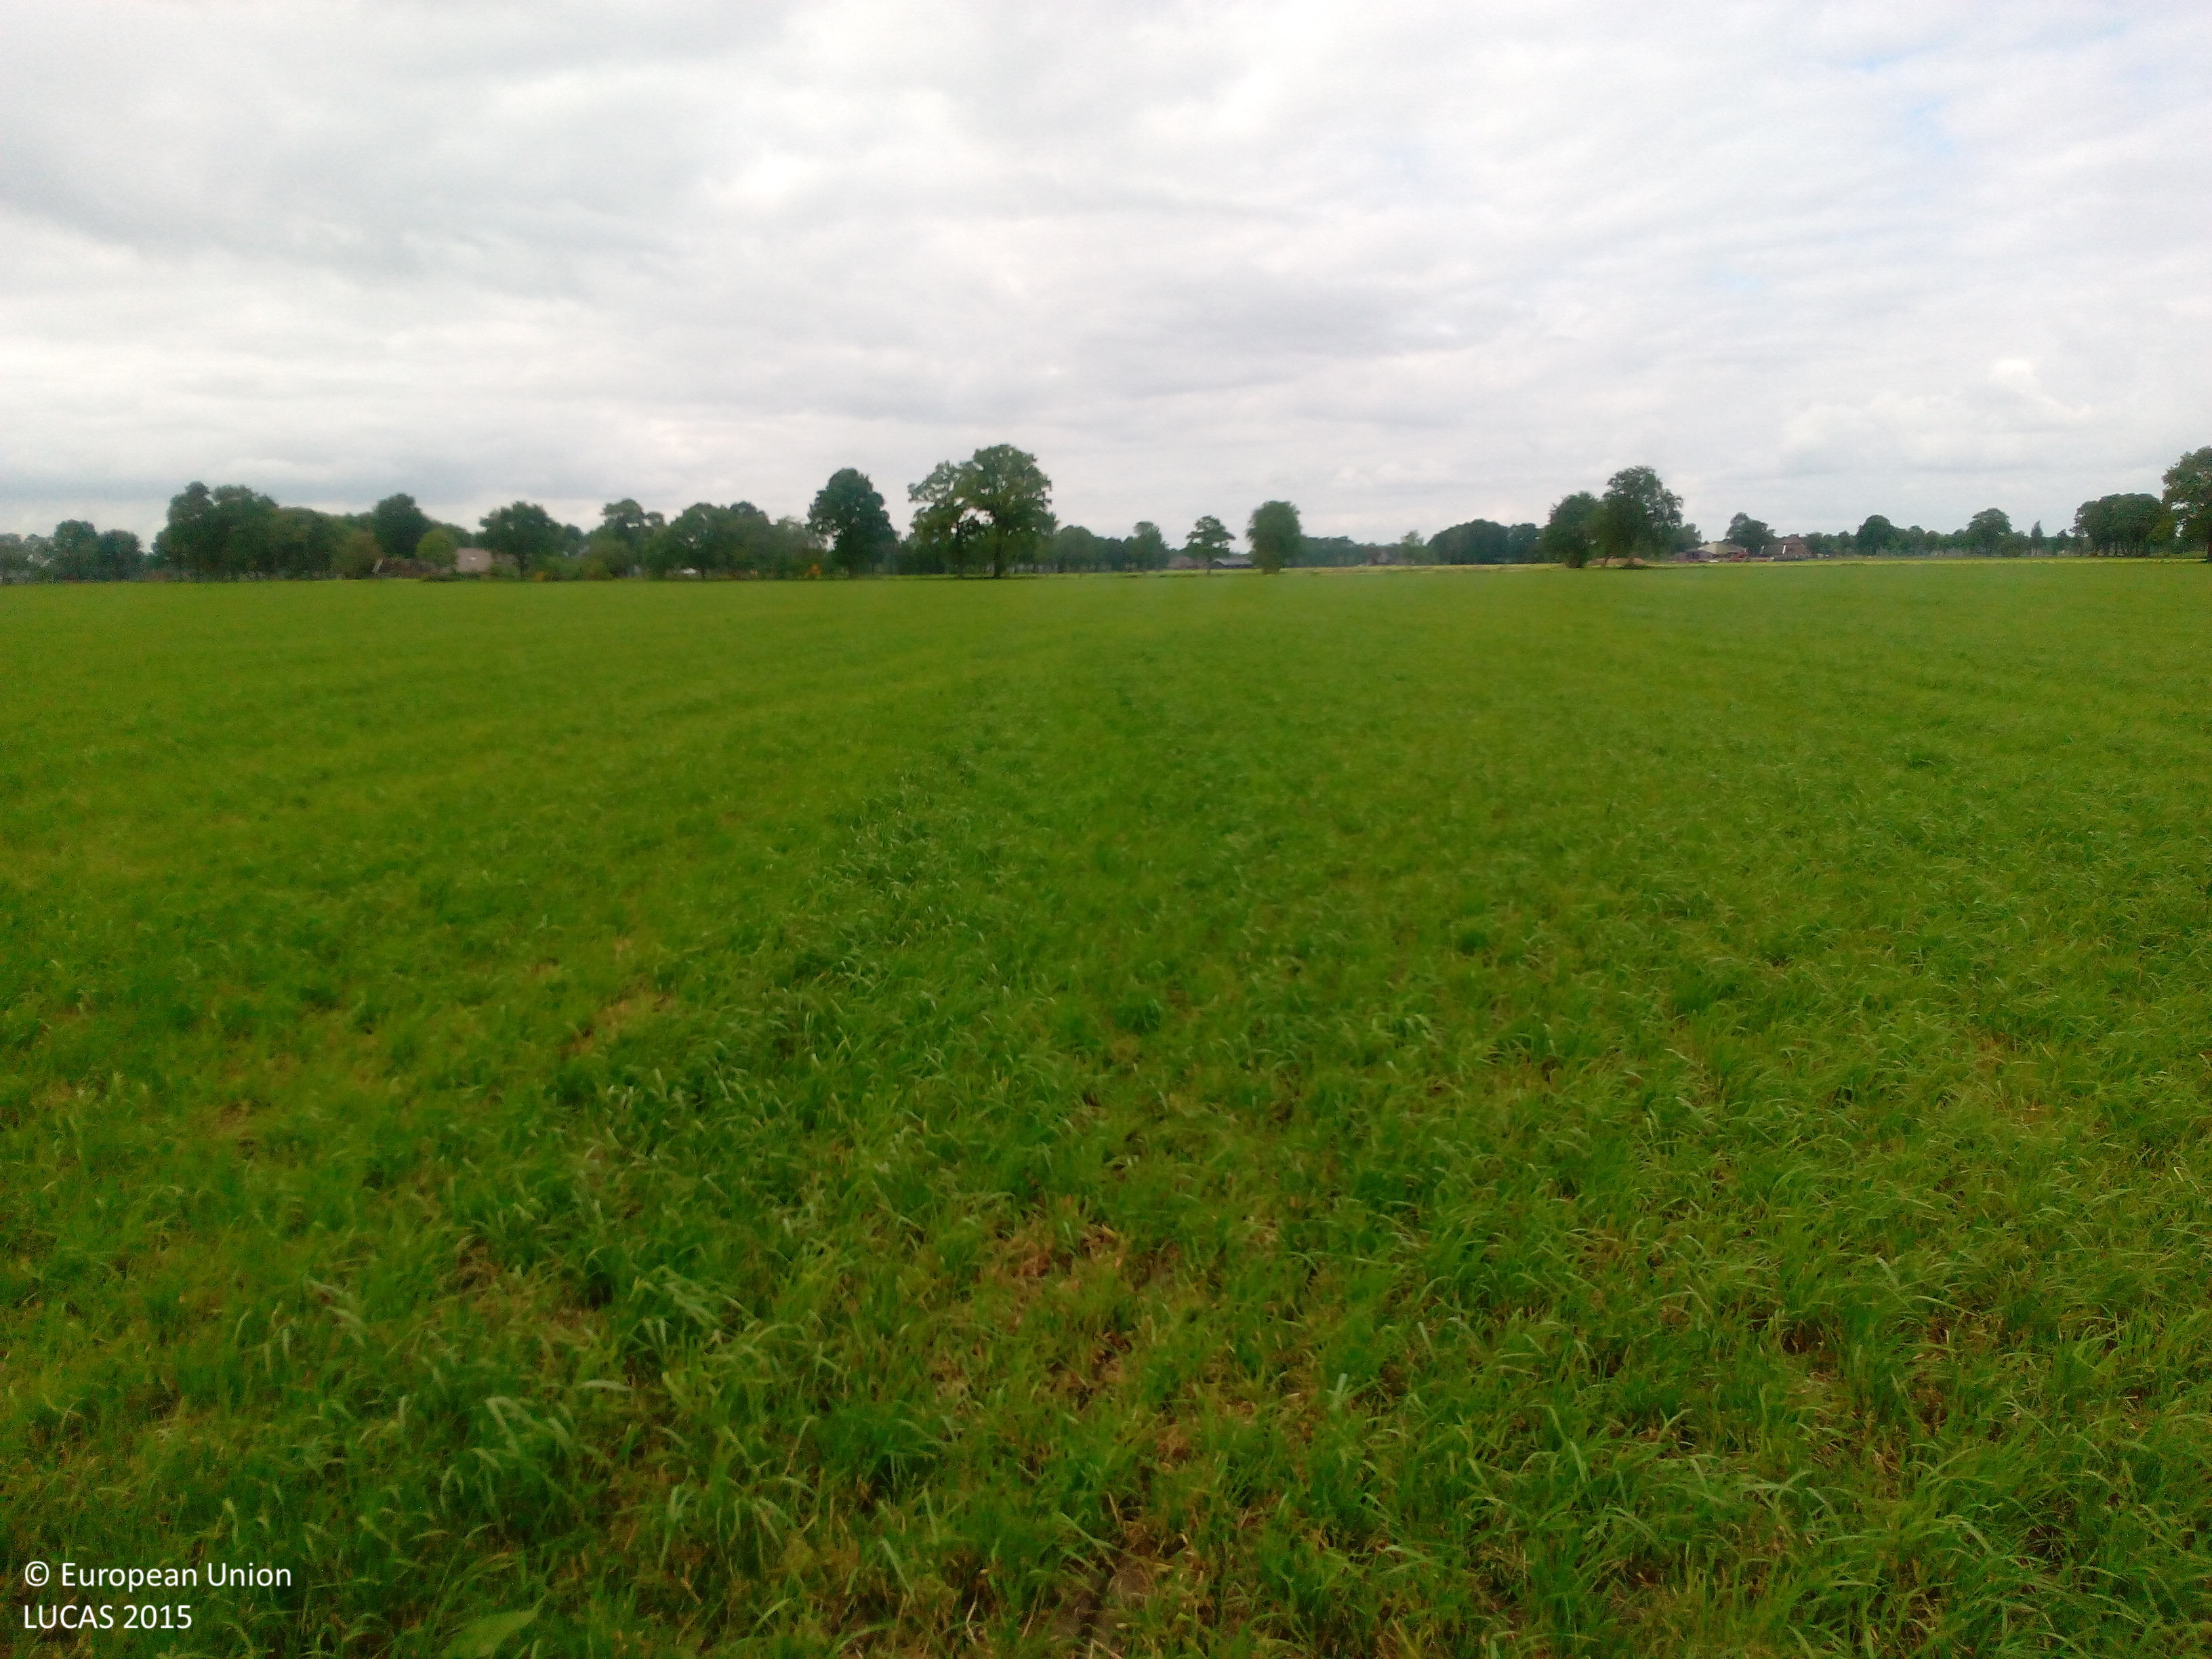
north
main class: Grassland
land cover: Grassland without tree/shrub cover
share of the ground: > 75 %
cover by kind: herbaceous plants 90 %, unconsolidated bare surface 10 %
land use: Agriculture (excluding fallow land and kitchen gardens)
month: May
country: NL
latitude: 52.3186
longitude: 6.2586
